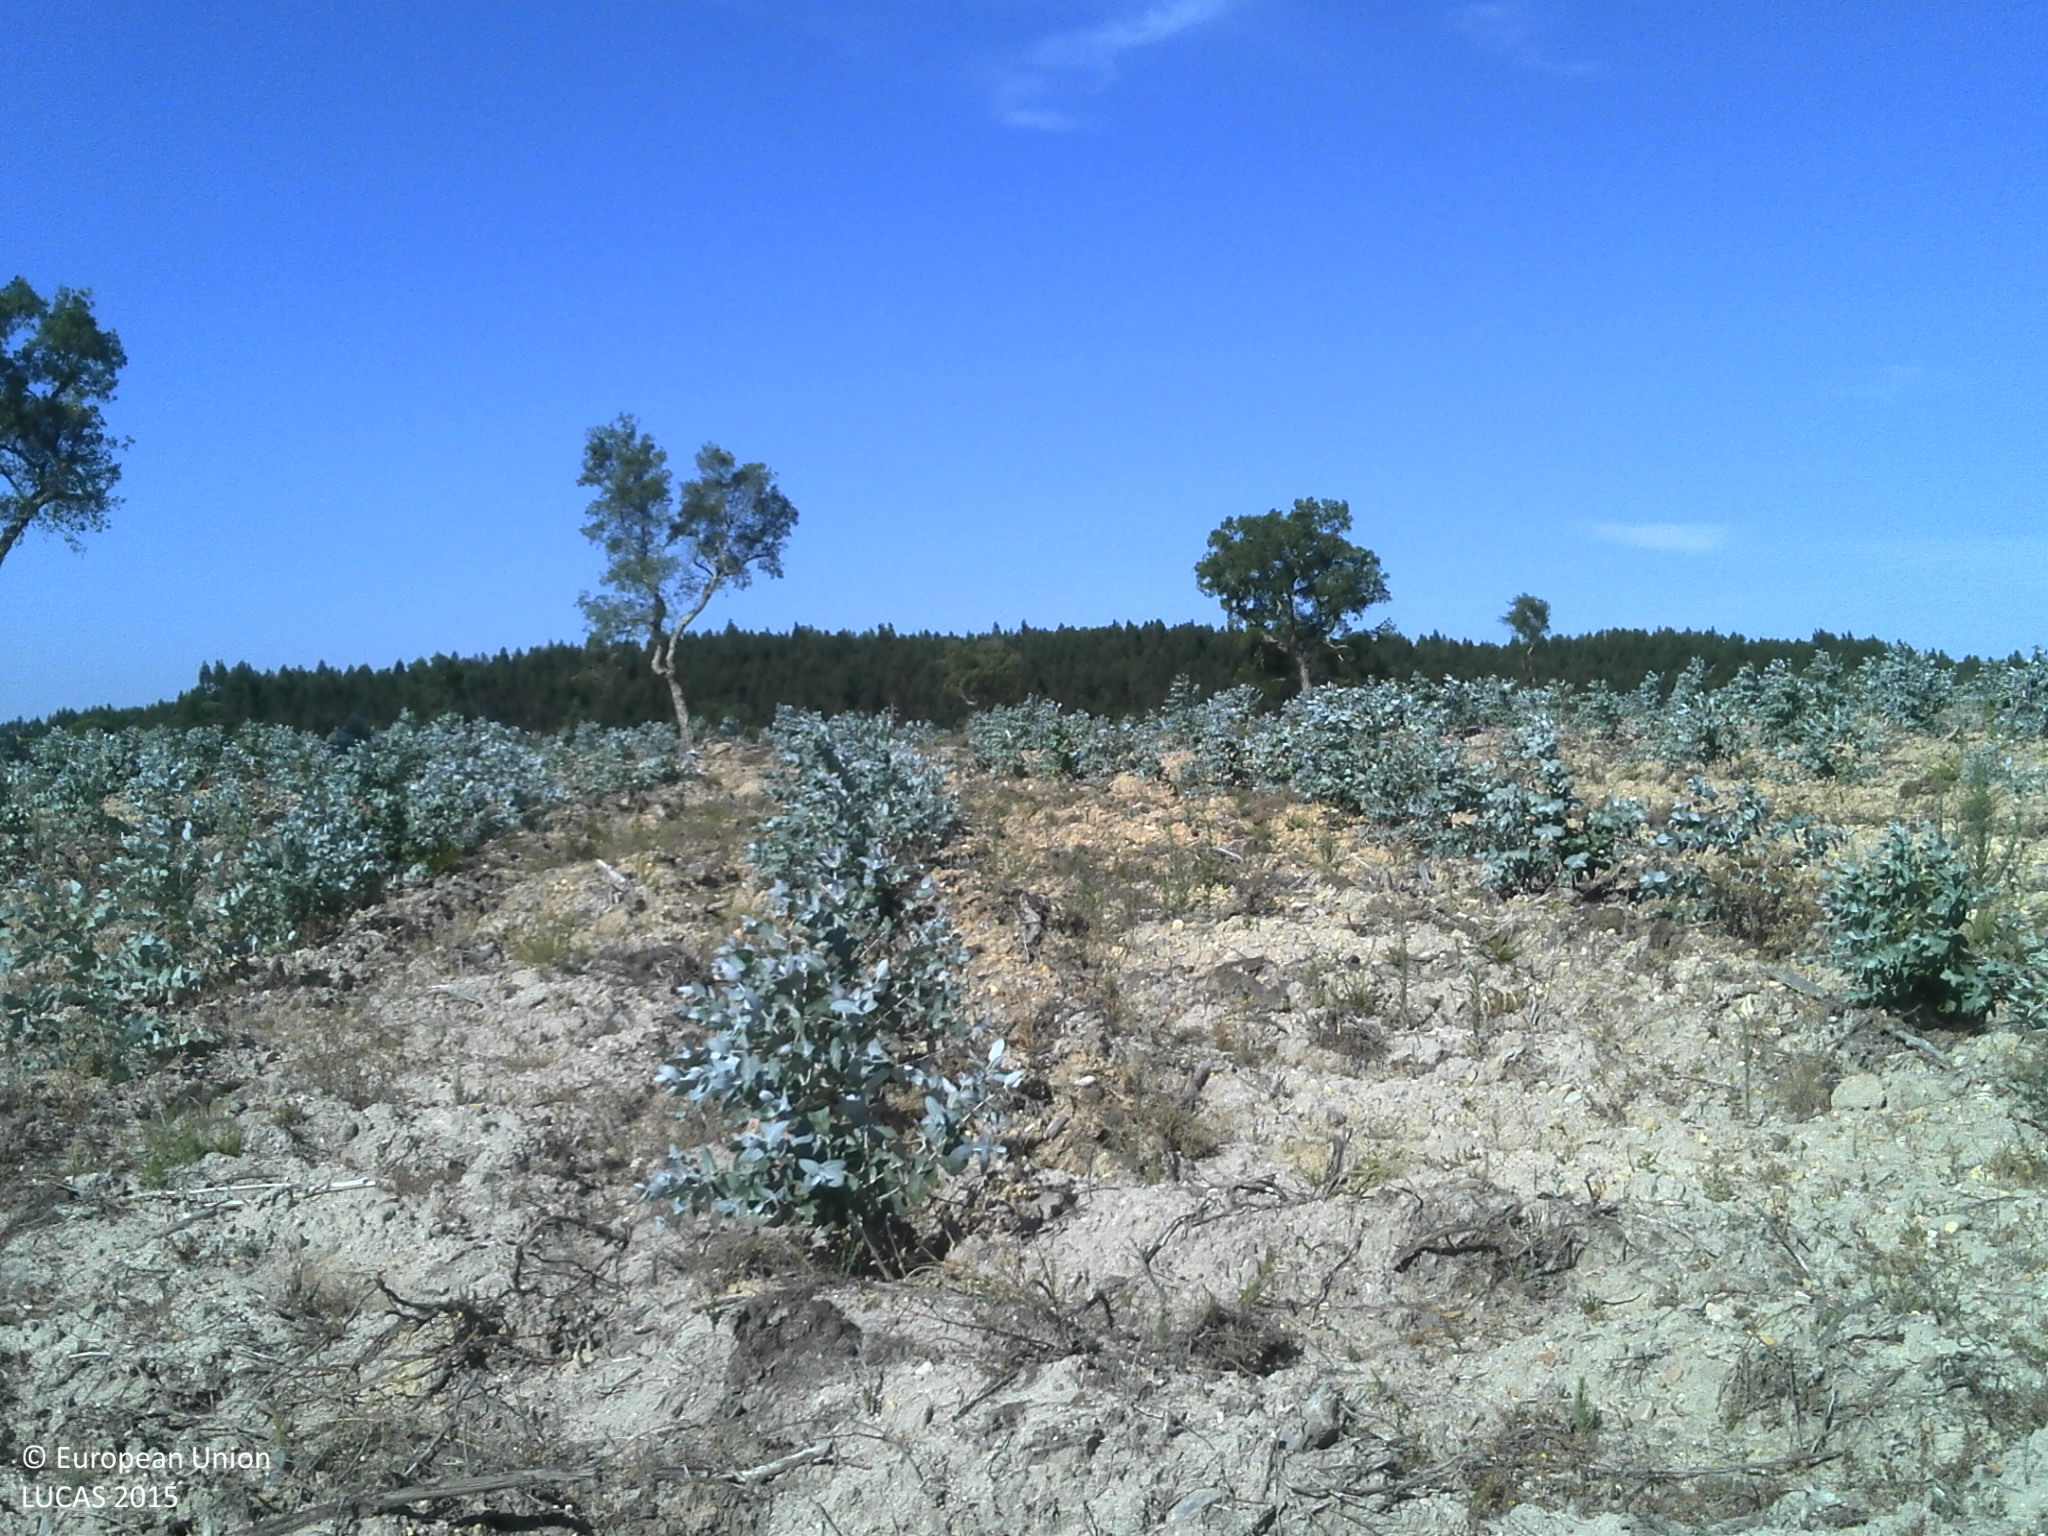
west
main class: Woodland
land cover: Broadleaved woodland
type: exotic forest
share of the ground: 25 - 50 %
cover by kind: unconsolidated bare surface 65 %, broadleaved forest trees 25 %, herbaceous plants 10 %
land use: Forestry
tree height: < 5 m
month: July
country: PT
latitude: 39.2090
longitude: -8.3252
